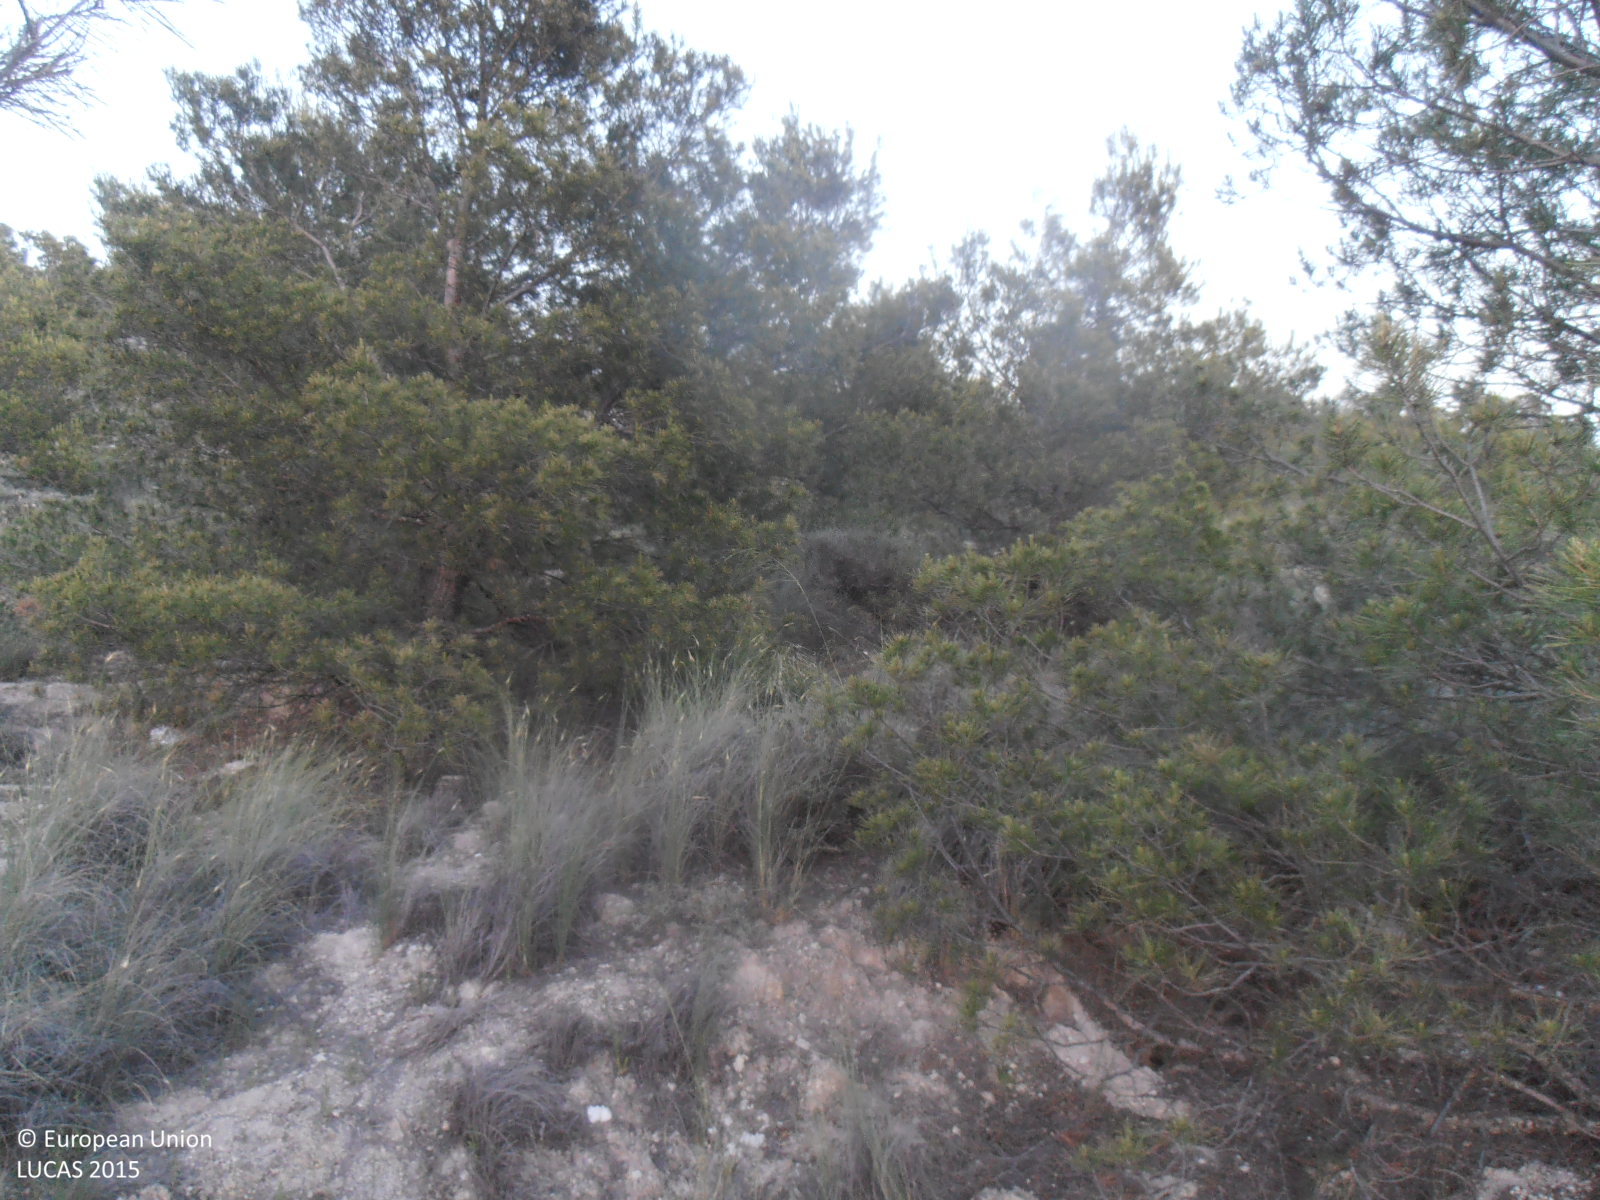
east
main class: Woodland
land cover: Pine dominated coniferous woodland
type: coniferous forest of the mediterranean region
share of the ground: 25 - 50 %
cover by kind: coniferous forest trees 45 %, shrubs 30 %, consolidated bare surface 25 %
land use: Forestry
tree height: < 5 m
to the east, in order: Pine dominated coniferous woodland; Tracks; Pine dominated coniferous woodland
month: May
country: ES
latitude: 41.5772
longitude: -1.0204
